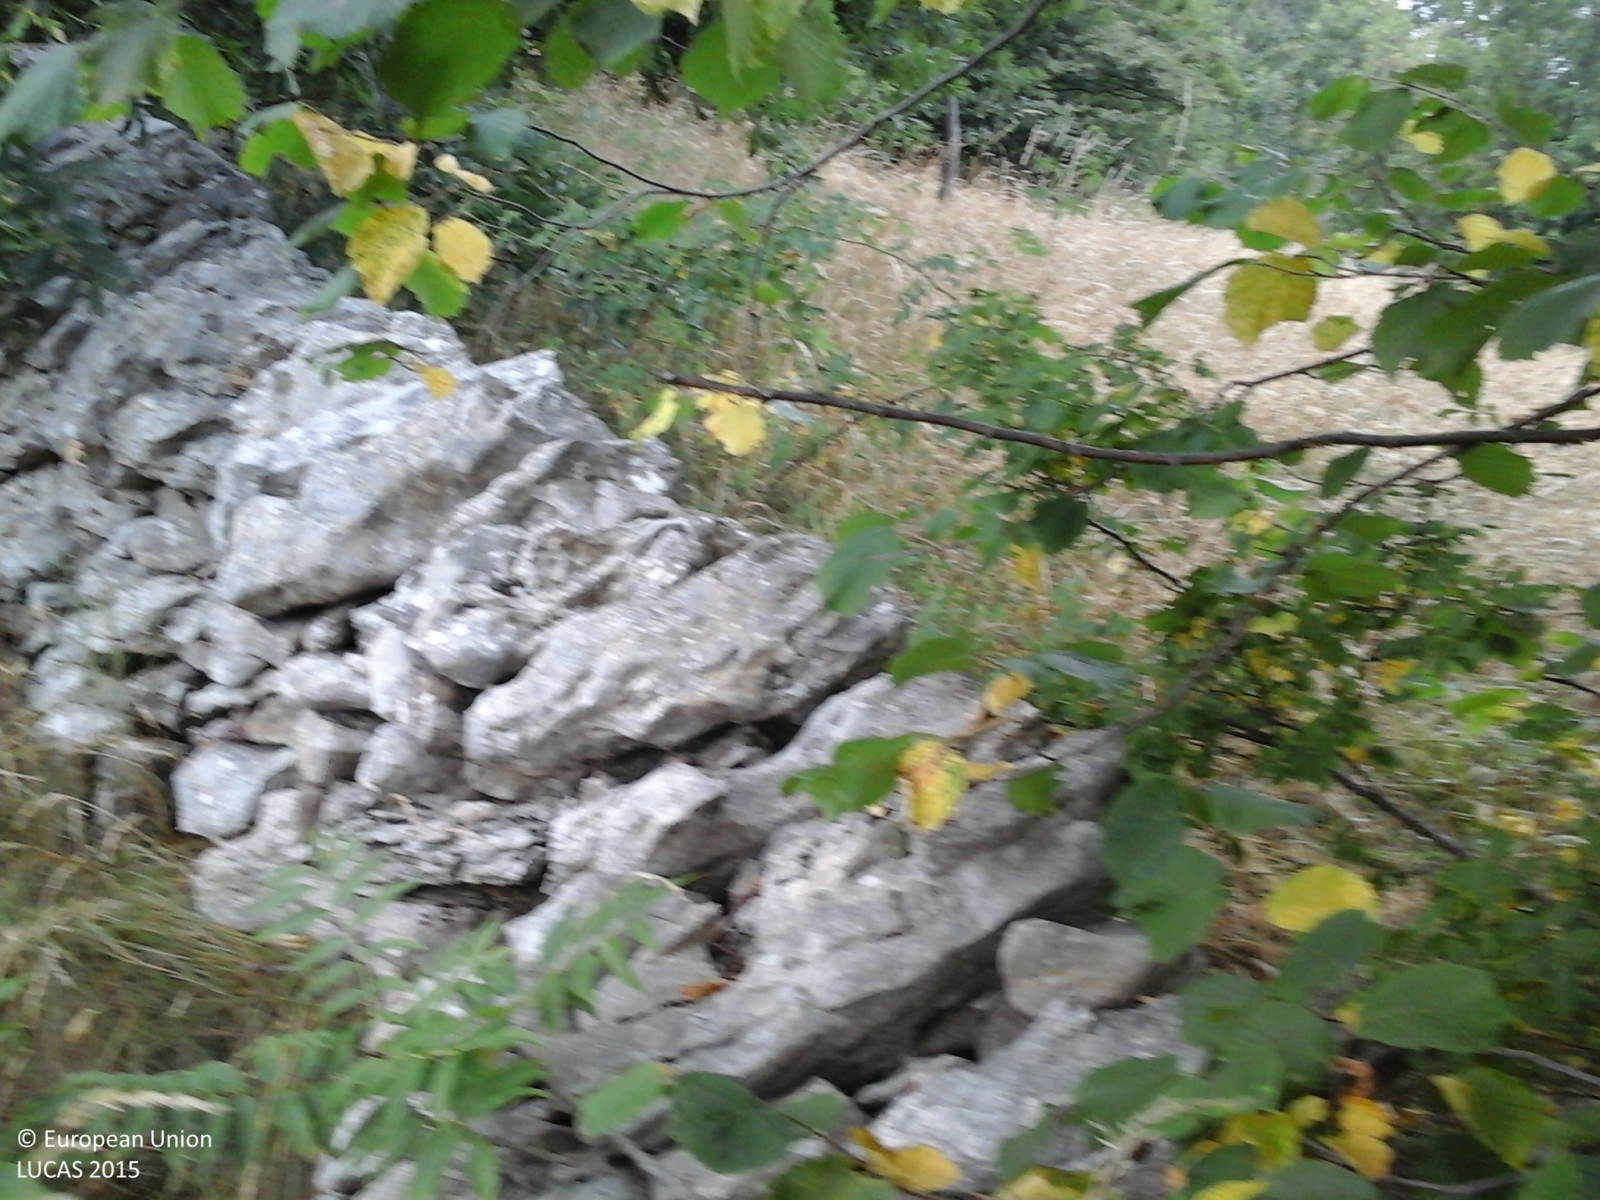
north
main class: Woodland
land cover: Broadleaved woodland
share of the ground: > 75 %
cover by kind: broadleaved forest trees 100 %
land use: Forestry
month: July
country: IT
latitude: 45.6247
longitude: 11.1141
